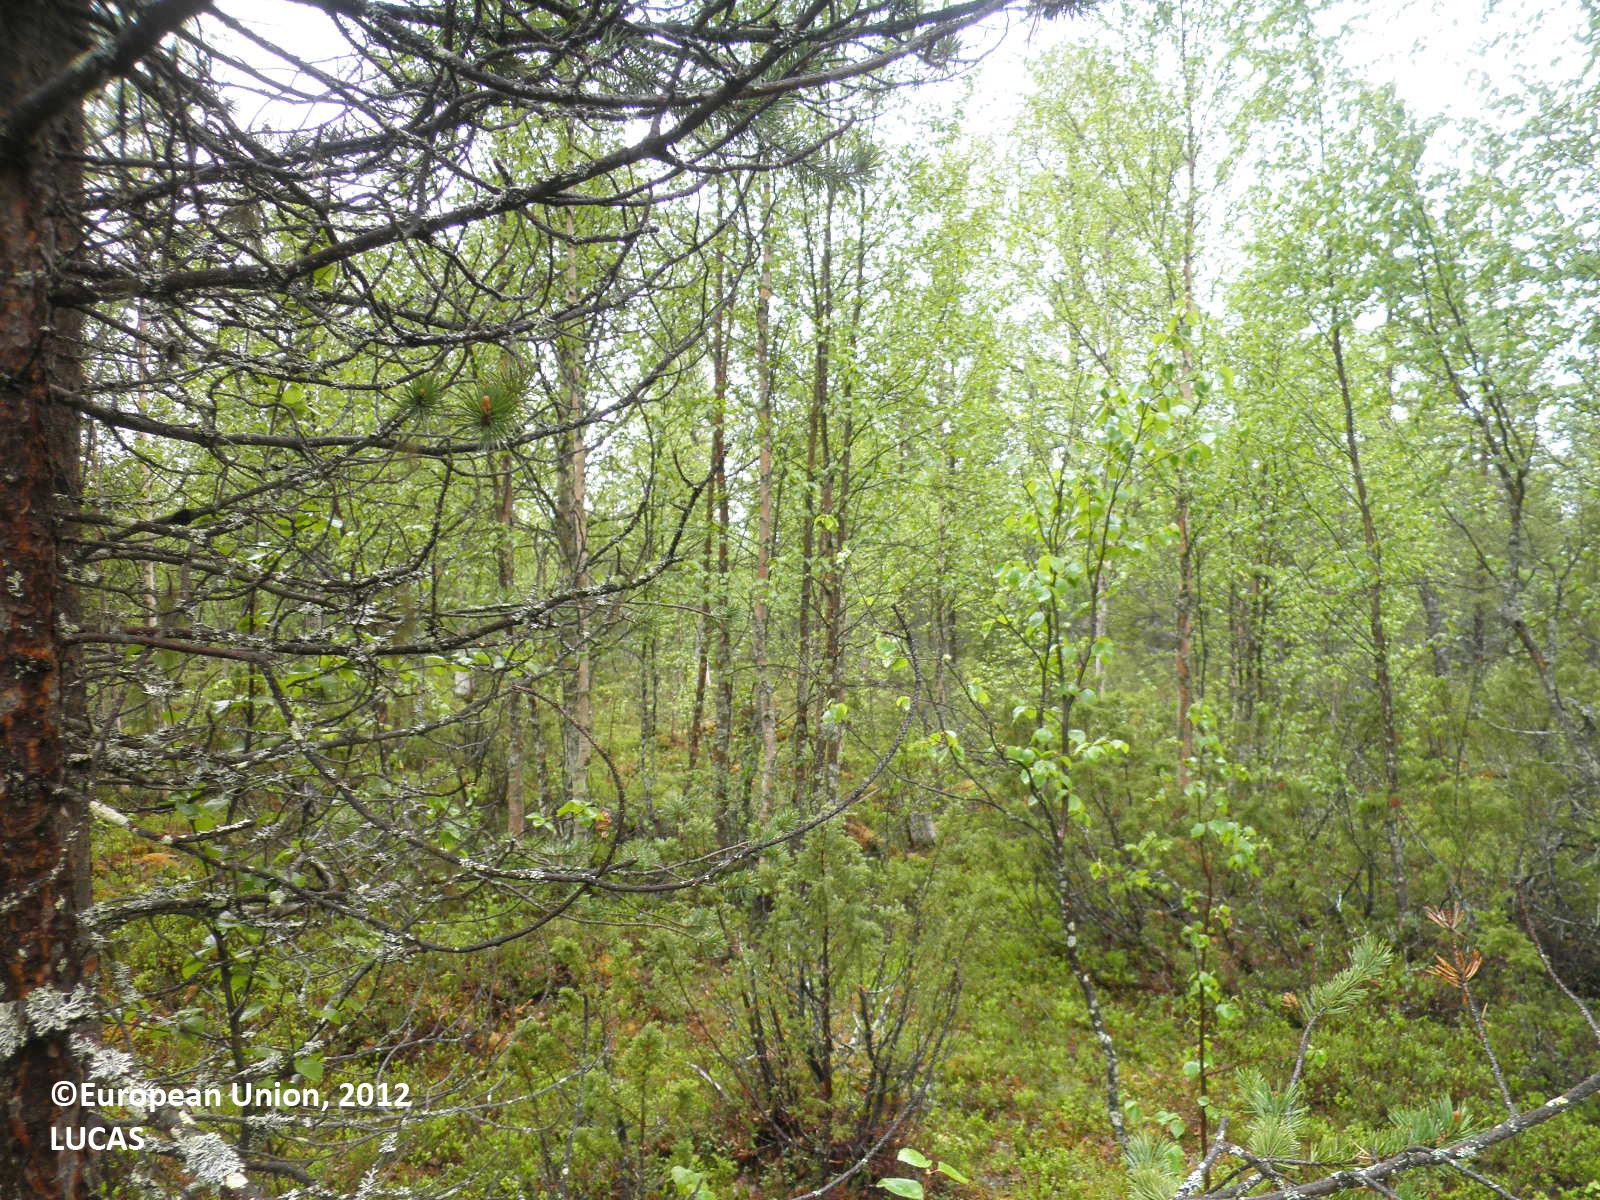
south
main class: Woodland
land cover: Pine dominated mixed woodland
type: boreal forest
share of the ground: > 75 %
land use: Forestry
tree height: > 5 m
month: June
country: FI
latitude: 68.0204
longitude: 25.7274
